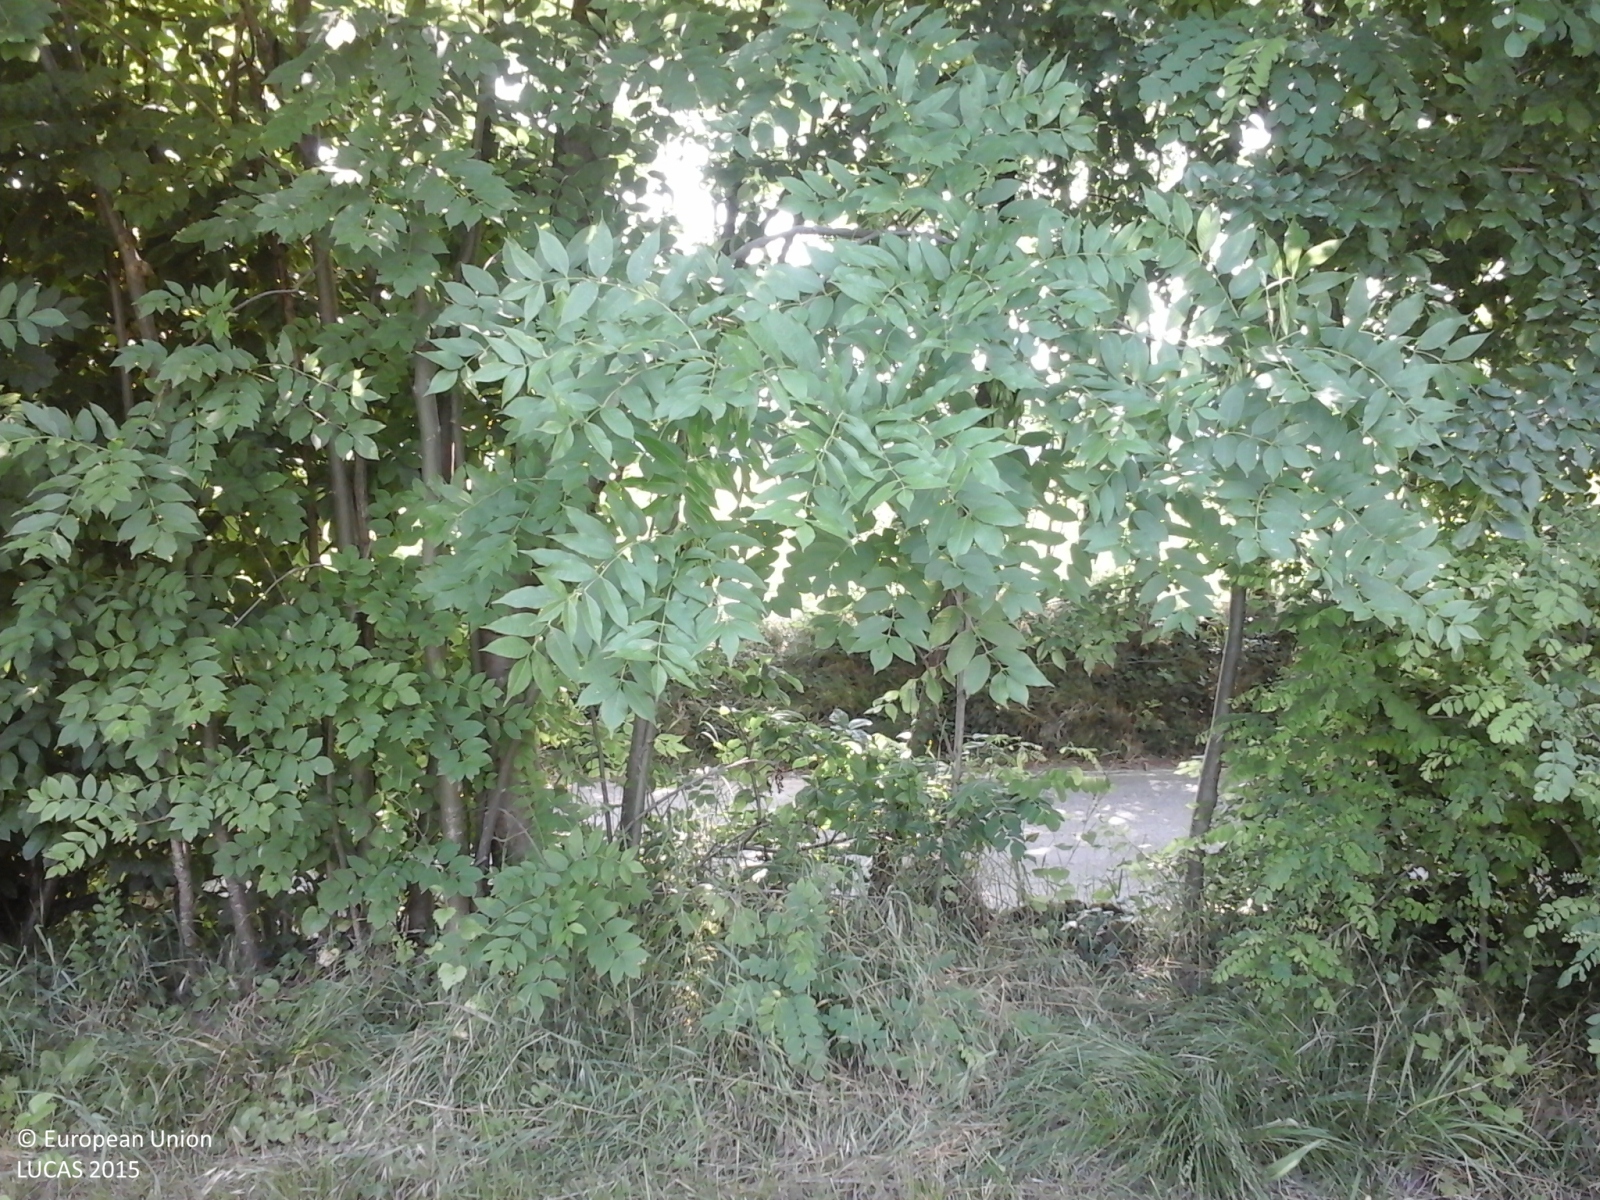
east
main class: Grassland
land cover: Grassland with sparse tree/shrub cover
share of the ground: > 75 %
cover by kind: herbaceous plants 90 %, broadleaved forest trees 5 %, shrubs 5 %
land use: Residential
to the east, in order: Grassland with sparse tree/shrub cover; Fences; Grassland without tree/shrub cover; Lines of trees; Grass margins; Paved roads, cycling and walking lanes; Grass margins; Lines of trees; Grassland without tree/shrub cover; Maize
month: May
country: IT
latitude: 45.2264
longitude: 7.6732
